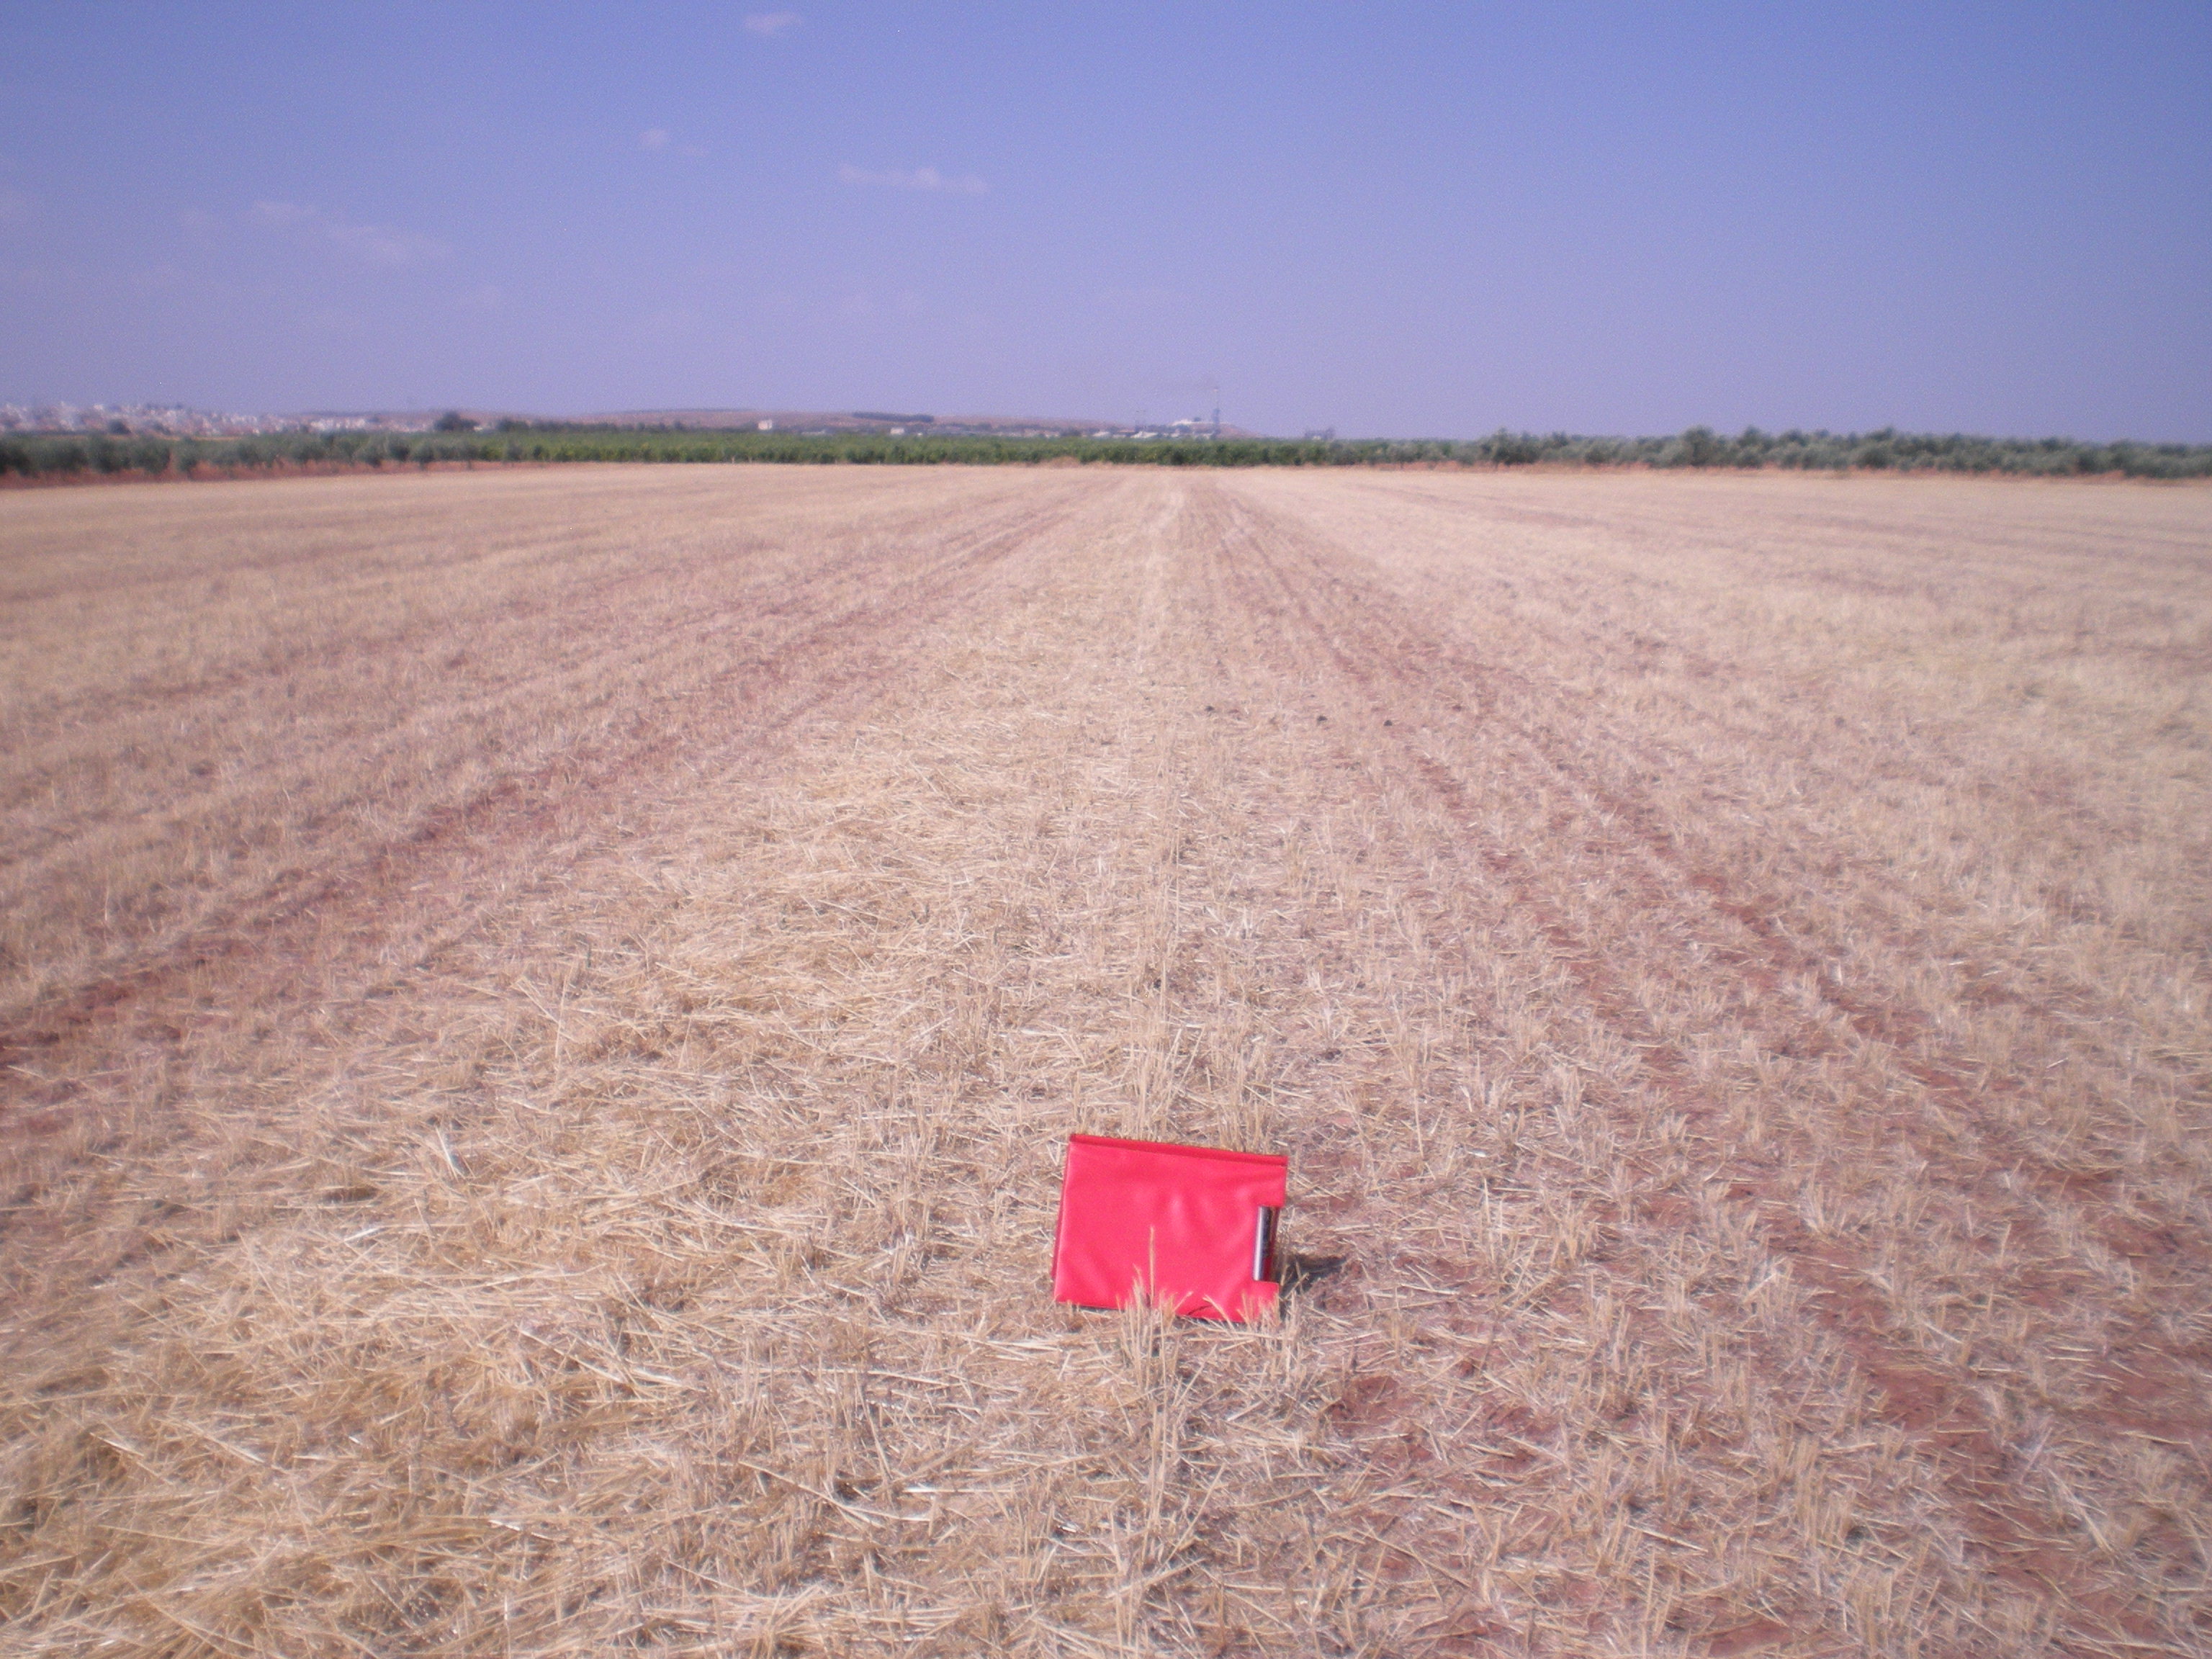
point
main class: Cropland
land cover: Barley
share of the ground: < 10 %
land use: Agriculture (excluding fallow land and kitchen gardens)
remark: Harvested field
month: July
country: ES
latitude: 39.3785
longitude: -3.1465
